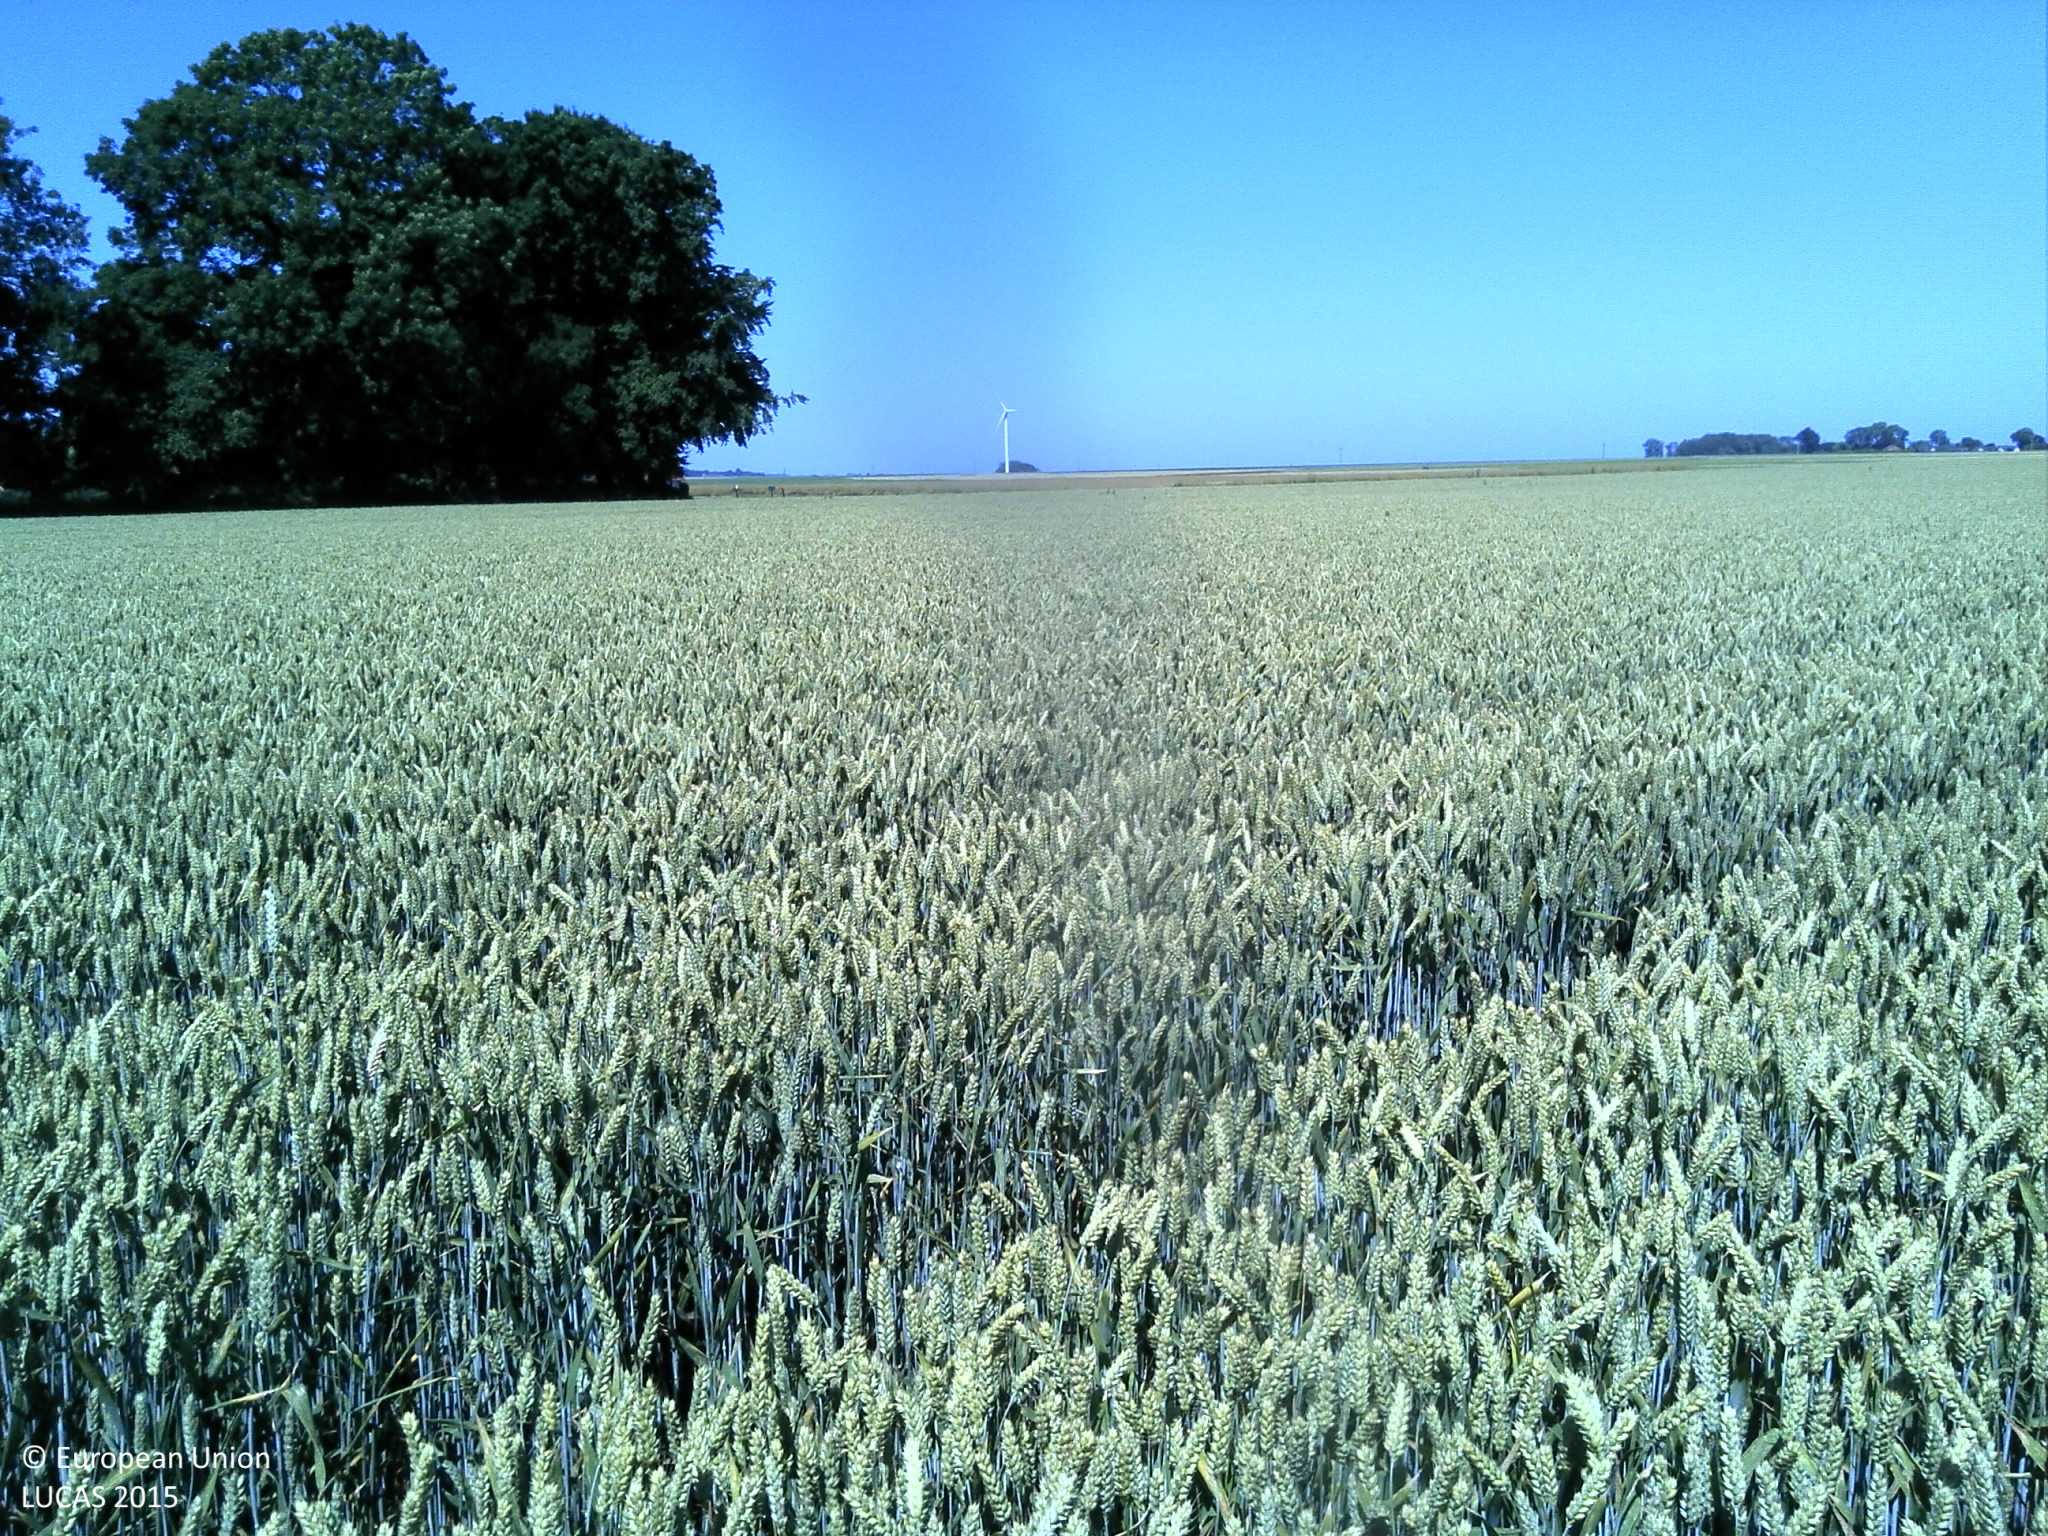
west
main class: Cropland
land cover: Common wheat
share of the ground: > 75 %
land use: Agriculture (excluding fallow land and kitchen gardens)
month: June
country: FR
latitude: 49.8464
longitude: 1.0075
